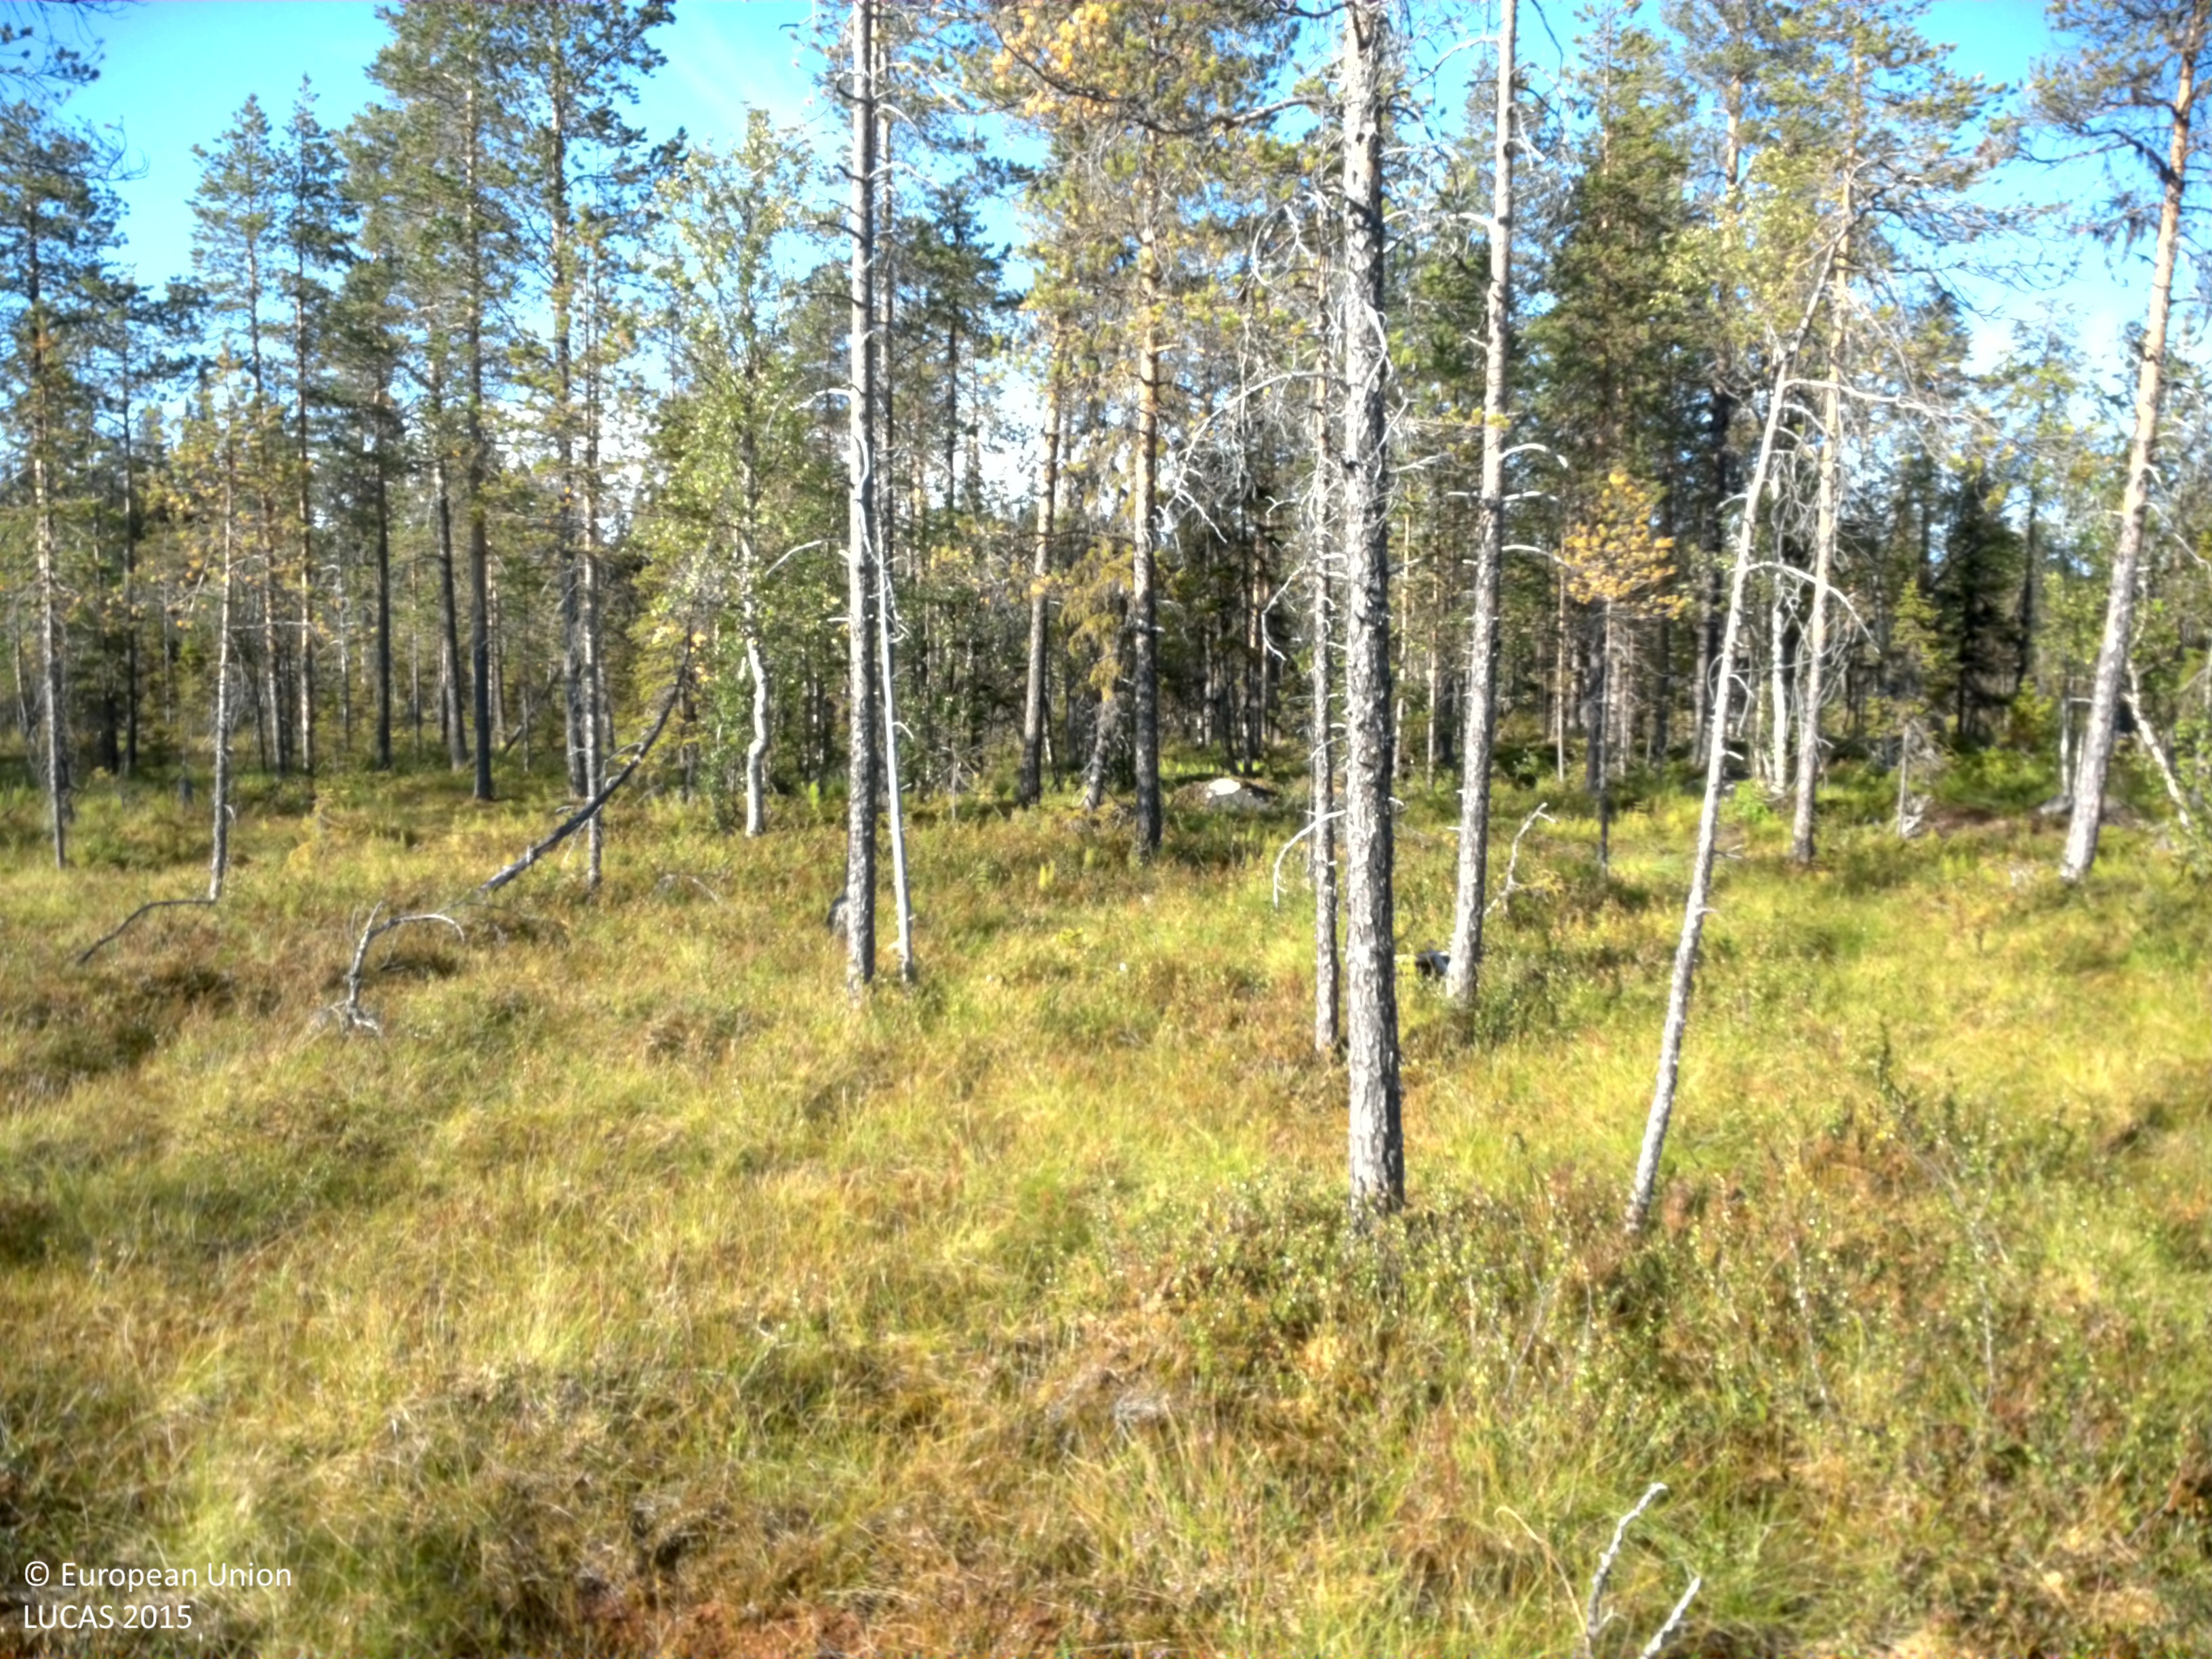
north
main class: Woodland
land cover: Pine dominated coniferous woodland
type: mire and swamp forests
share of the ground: 10 - 25 %
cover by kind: herbaceous plants 35 %, lichens and mosses 35 %, shrubs 20 %, coniferous forest trees 10 %
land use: Semi-natural and natural areas not in use
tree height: > 5 m
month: August
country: SE
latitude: 64.7099
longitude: 16.7007
